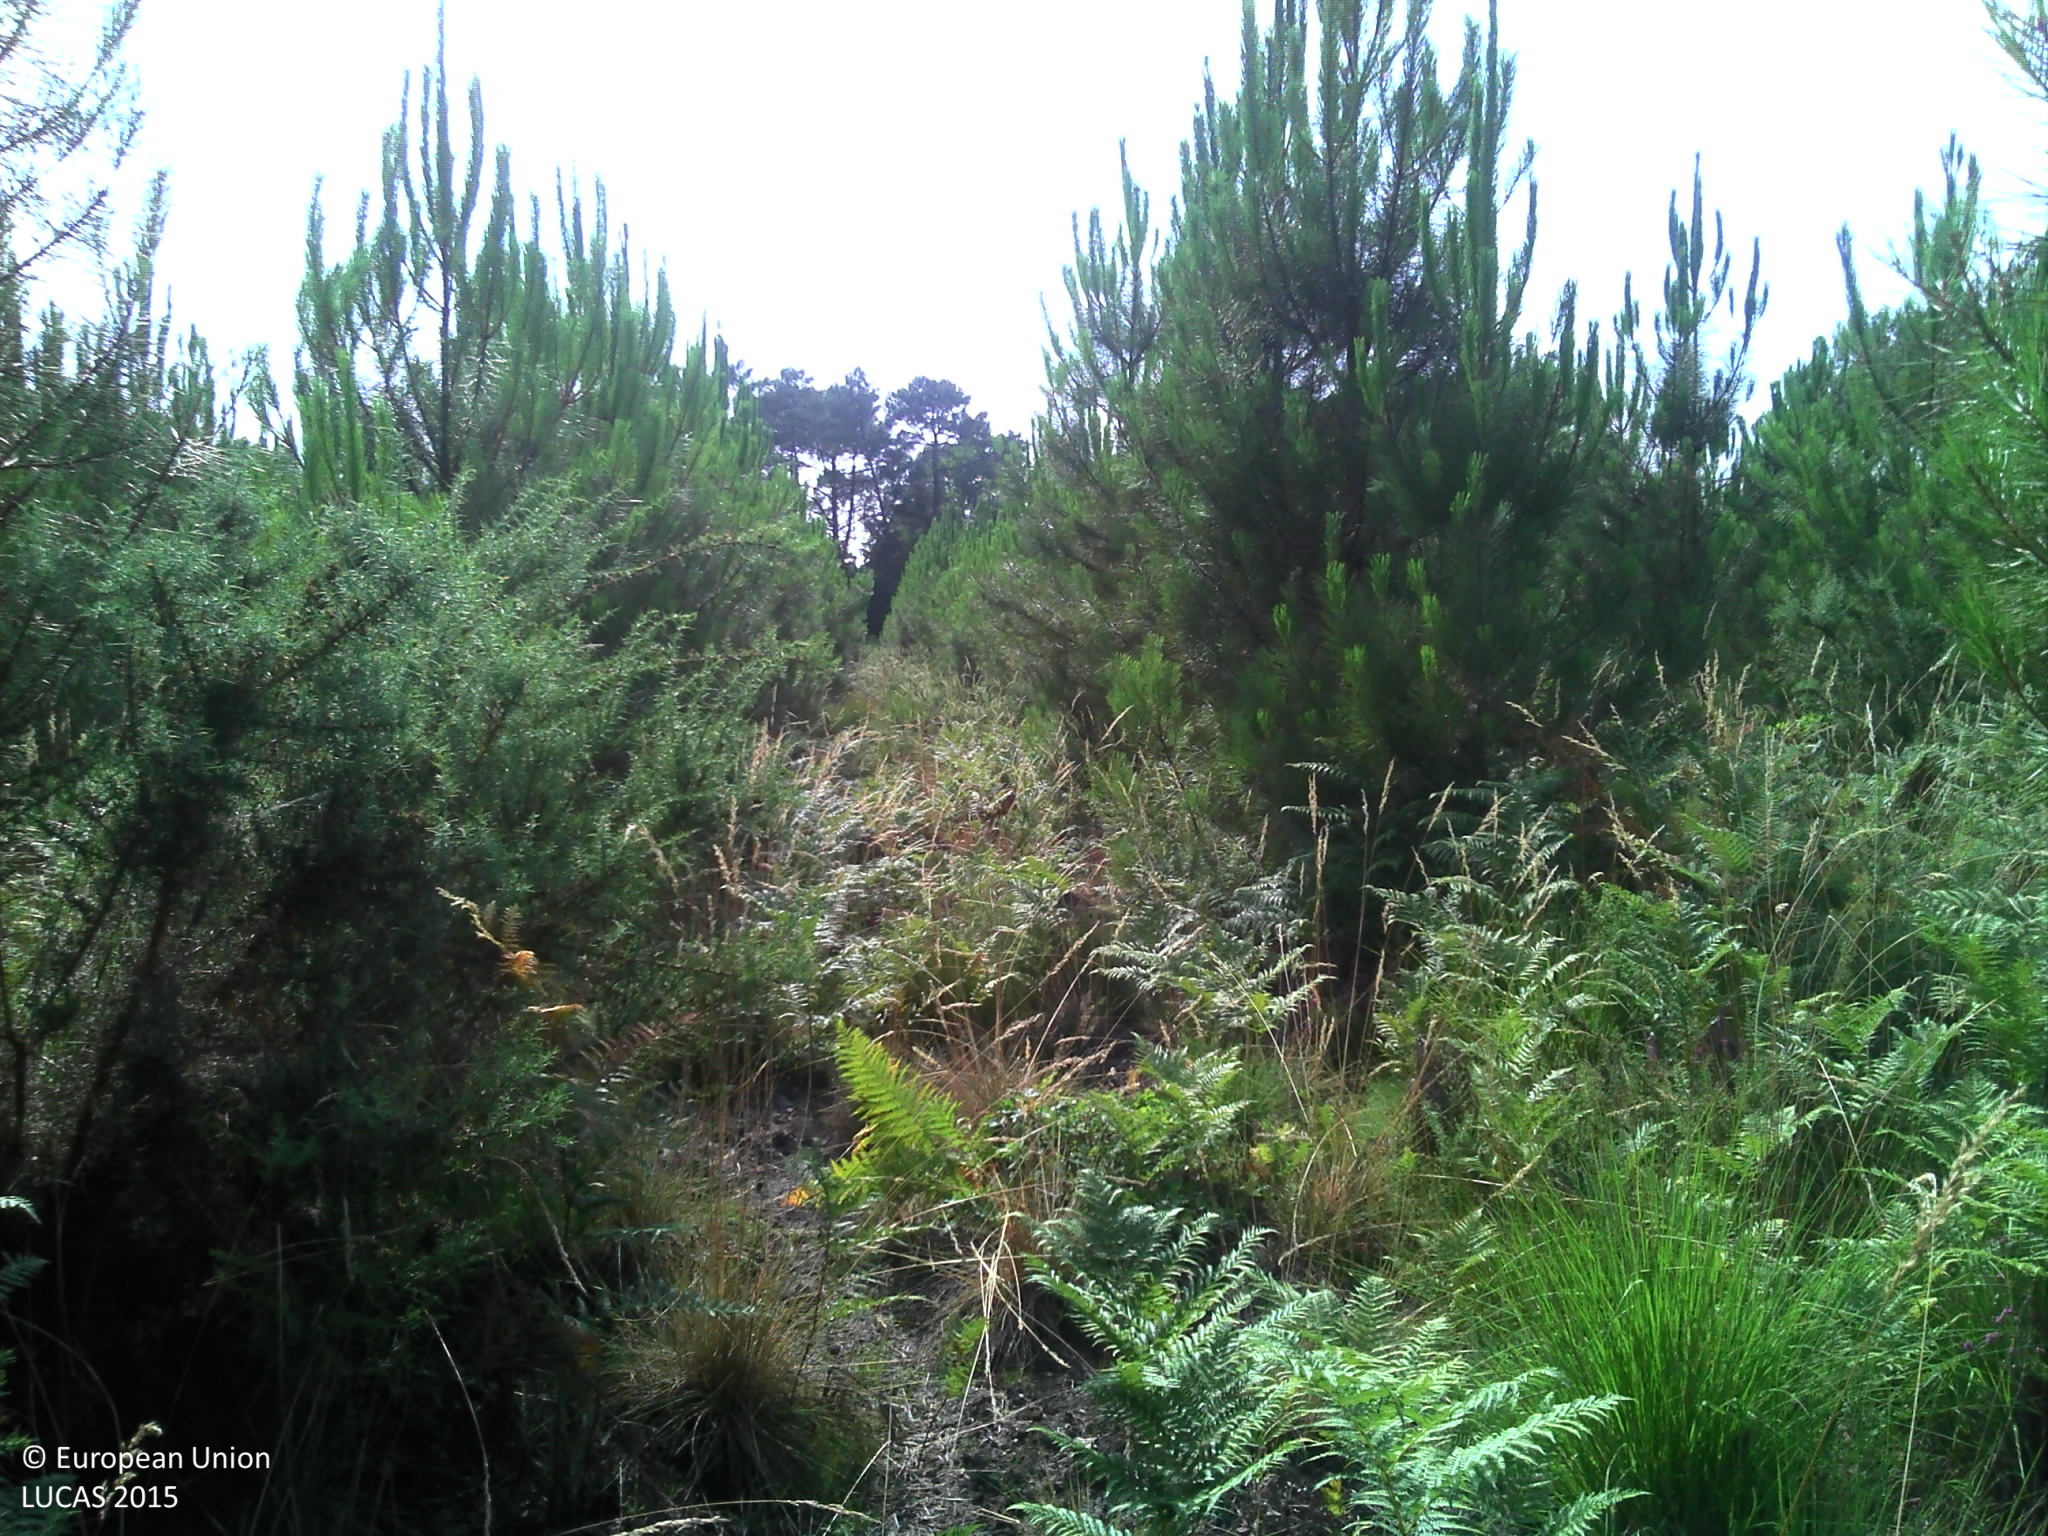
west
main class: Woodland
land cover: Pine dominated coniferous woodland
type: coniferous forest of the mediterranean region
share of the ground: > 75 %
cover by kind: coniferous forest trees 70 %, herbaceous plants 20 %, broadleaved forest trees 5 %, unconsolidated bare surface 5 %
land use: Forestry
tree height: < 5 m
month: July
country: FR
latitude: 43.7719
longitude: -1.2613
